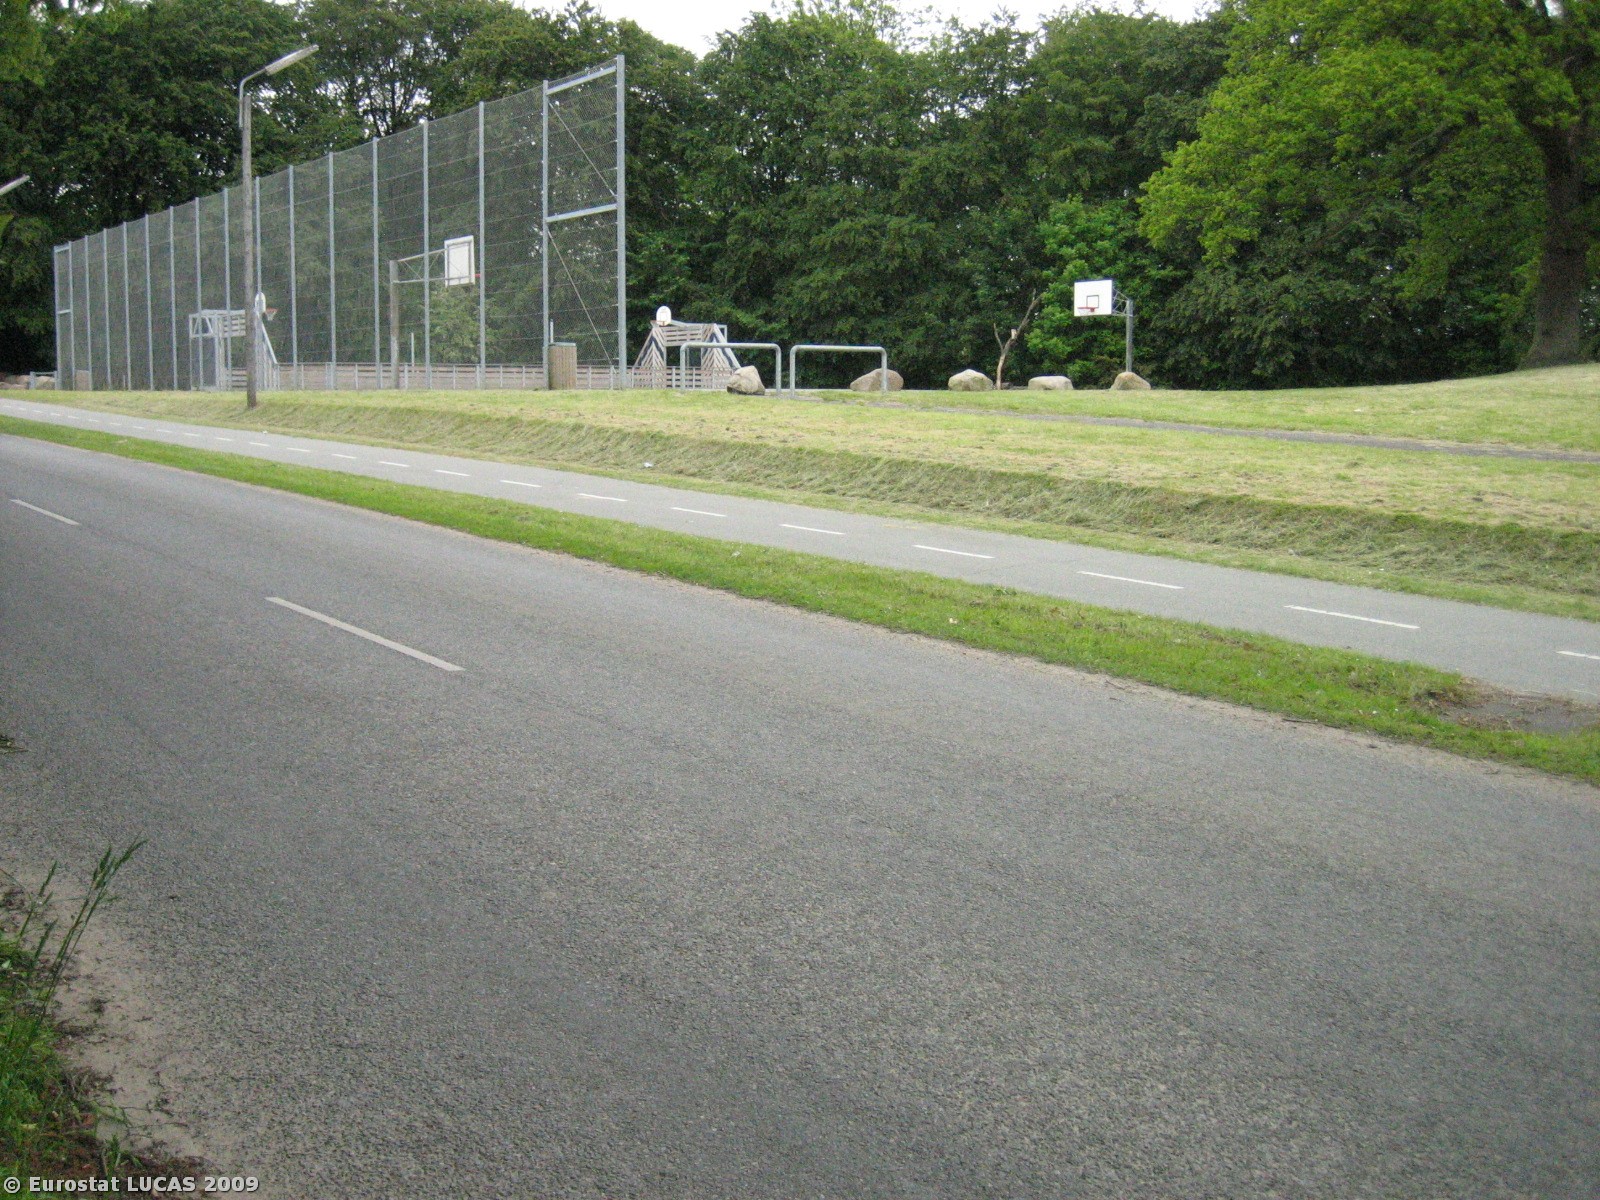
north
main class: Woodland
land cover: Broadleaved woodland
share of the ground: > 75 %
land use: Unused
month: June
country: DK
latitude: 56.2414
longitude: 10.2740
